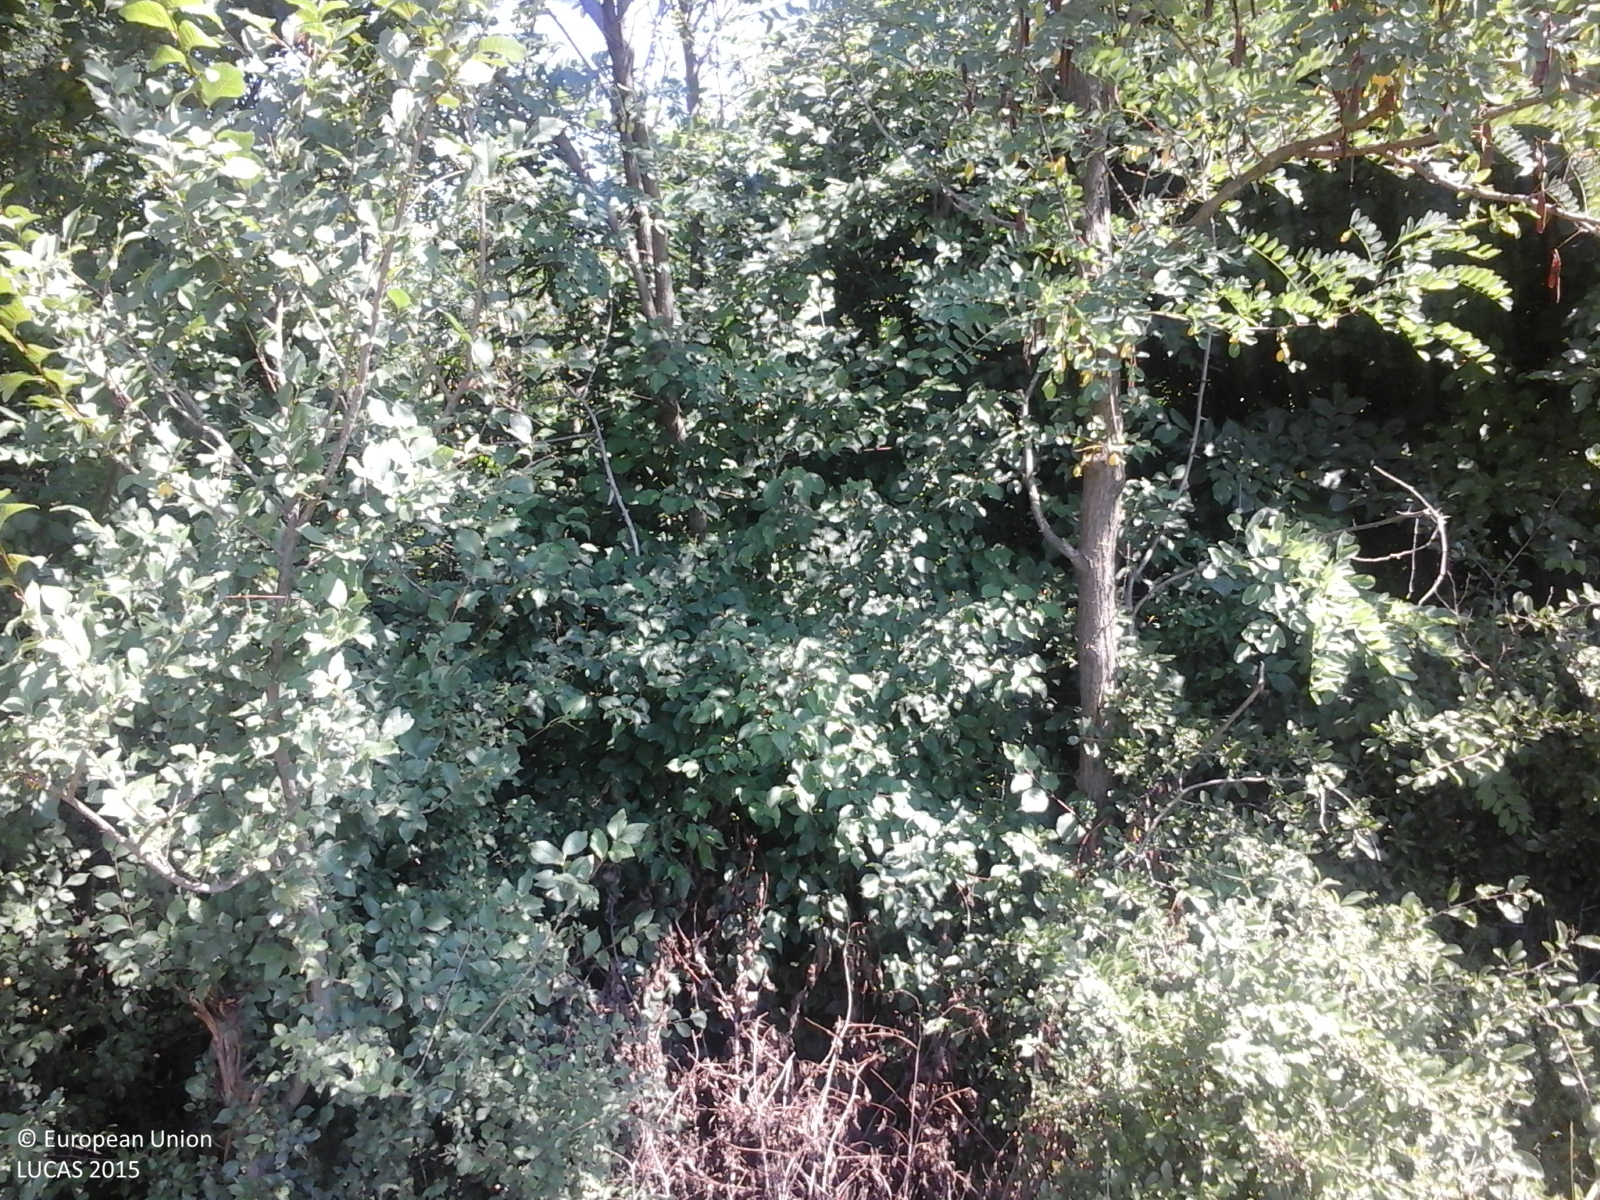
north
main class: Woodland
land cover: Broadleaved woodland
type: exotic forest
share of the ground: > 75 %
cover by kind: broadleaved forest trees 100 %
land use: Forestry
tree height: > 5 m
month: July
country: RO
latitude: 44.7194
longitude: 24.3483
